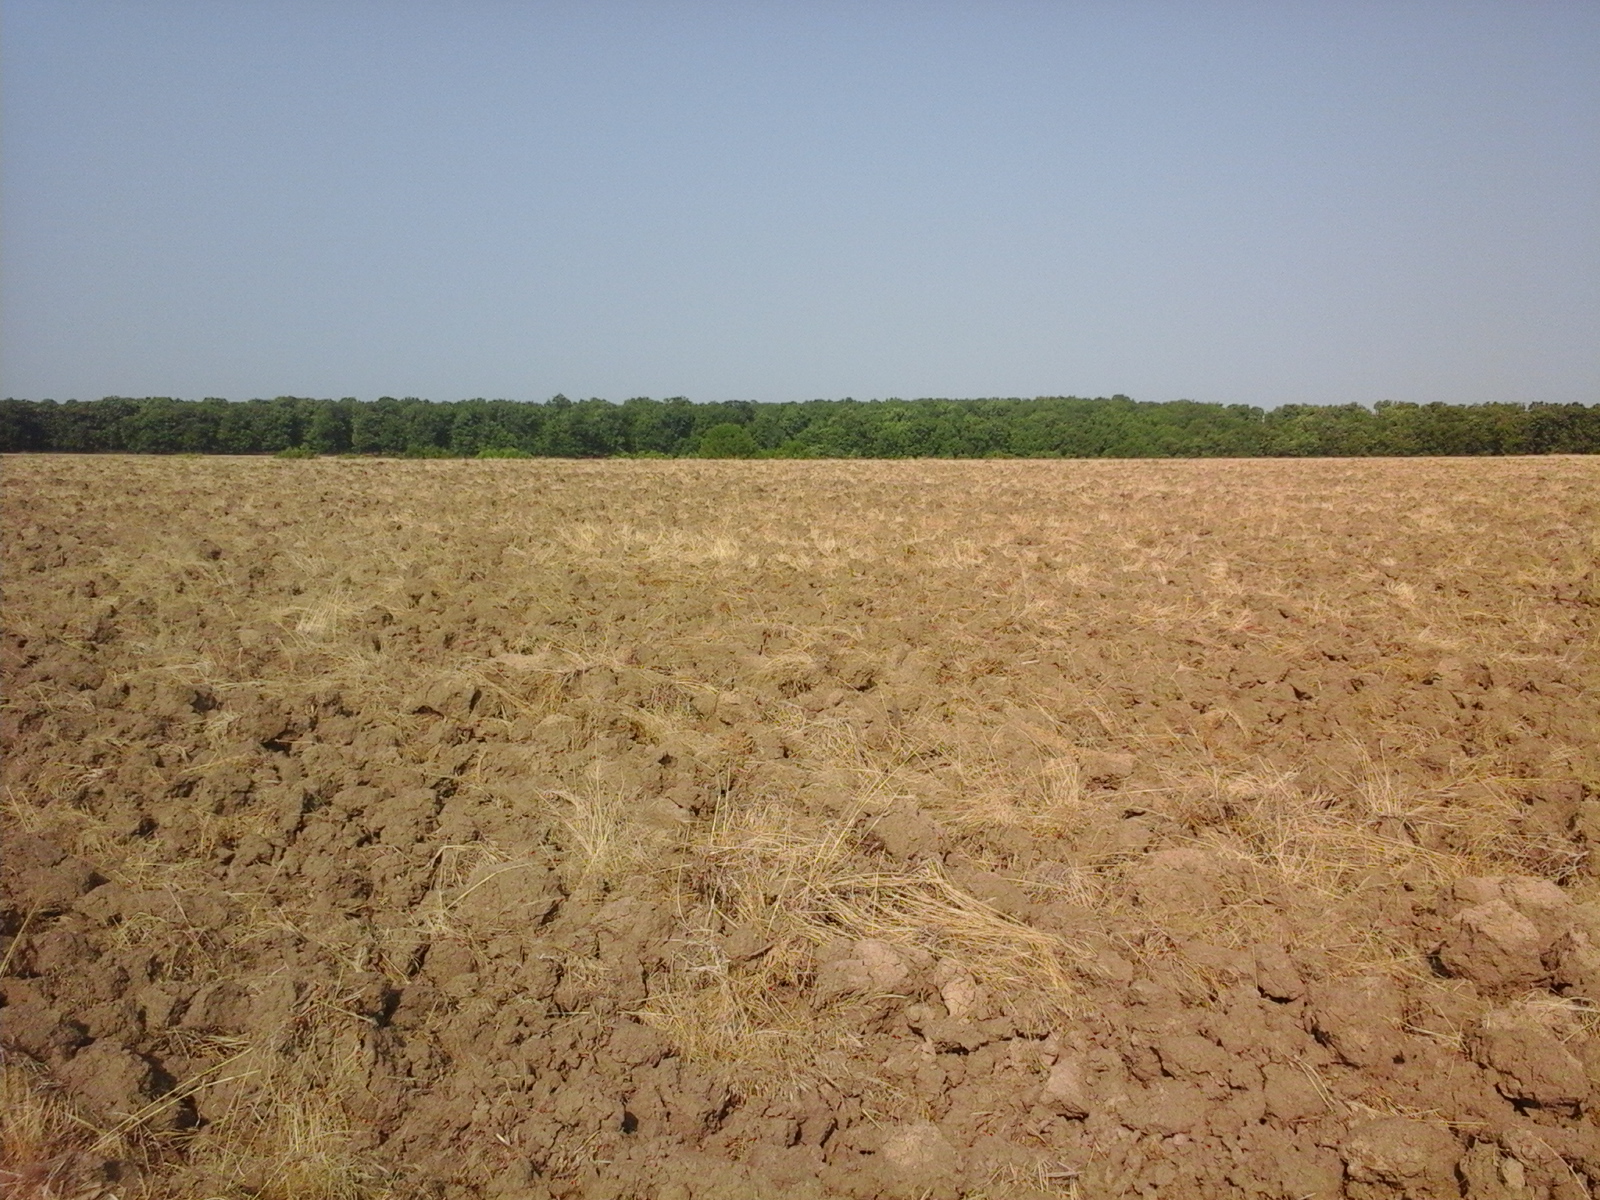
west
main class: Cropland
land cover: Temporary grasslands
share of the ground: 10 - 25 %
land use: Agriculture (excluding fallow land and kitchen gardens)
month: August
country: RO
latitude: 44.5717
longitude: 23.8228
